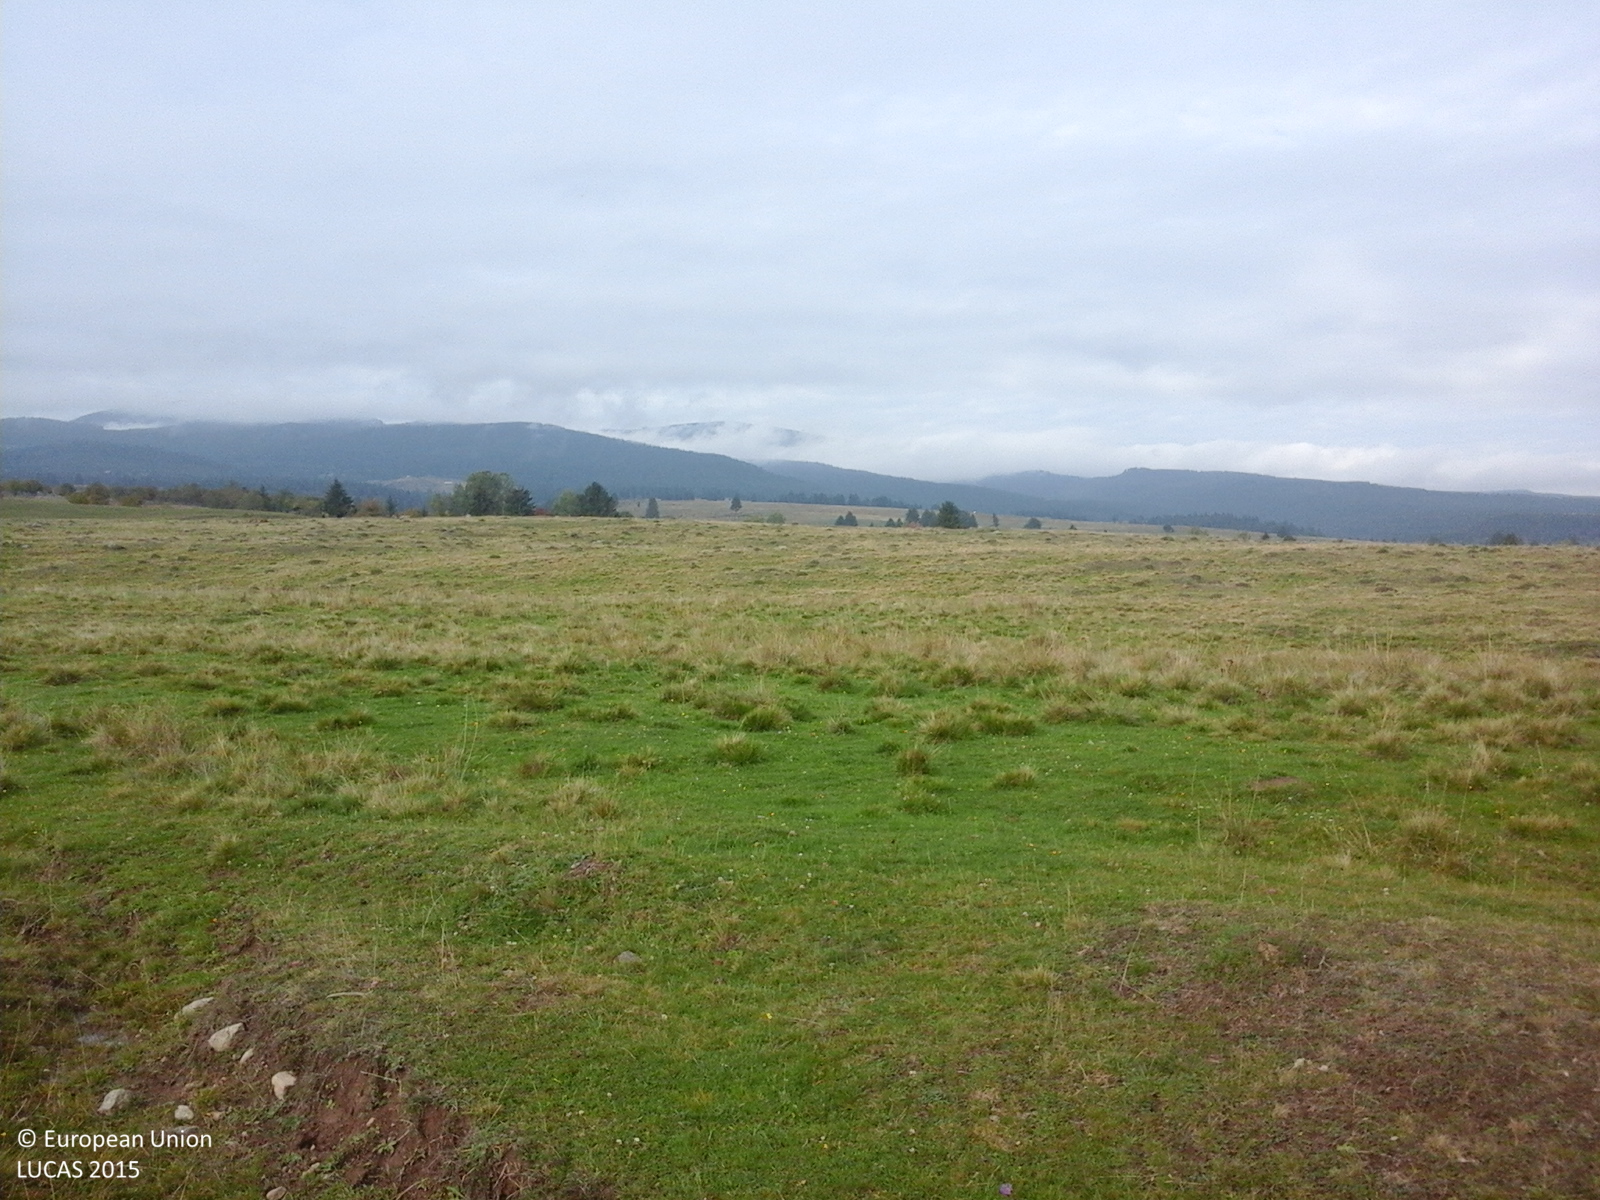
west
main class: Grassland
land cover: Grassland without tree/shrub cover
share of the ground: > 75 %
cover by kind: herbaceous plants 100 %
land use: Agriculture (excluding fallow land and kitchen gardens)
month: October
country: RO
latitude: 46.4271
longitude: 25.7159
